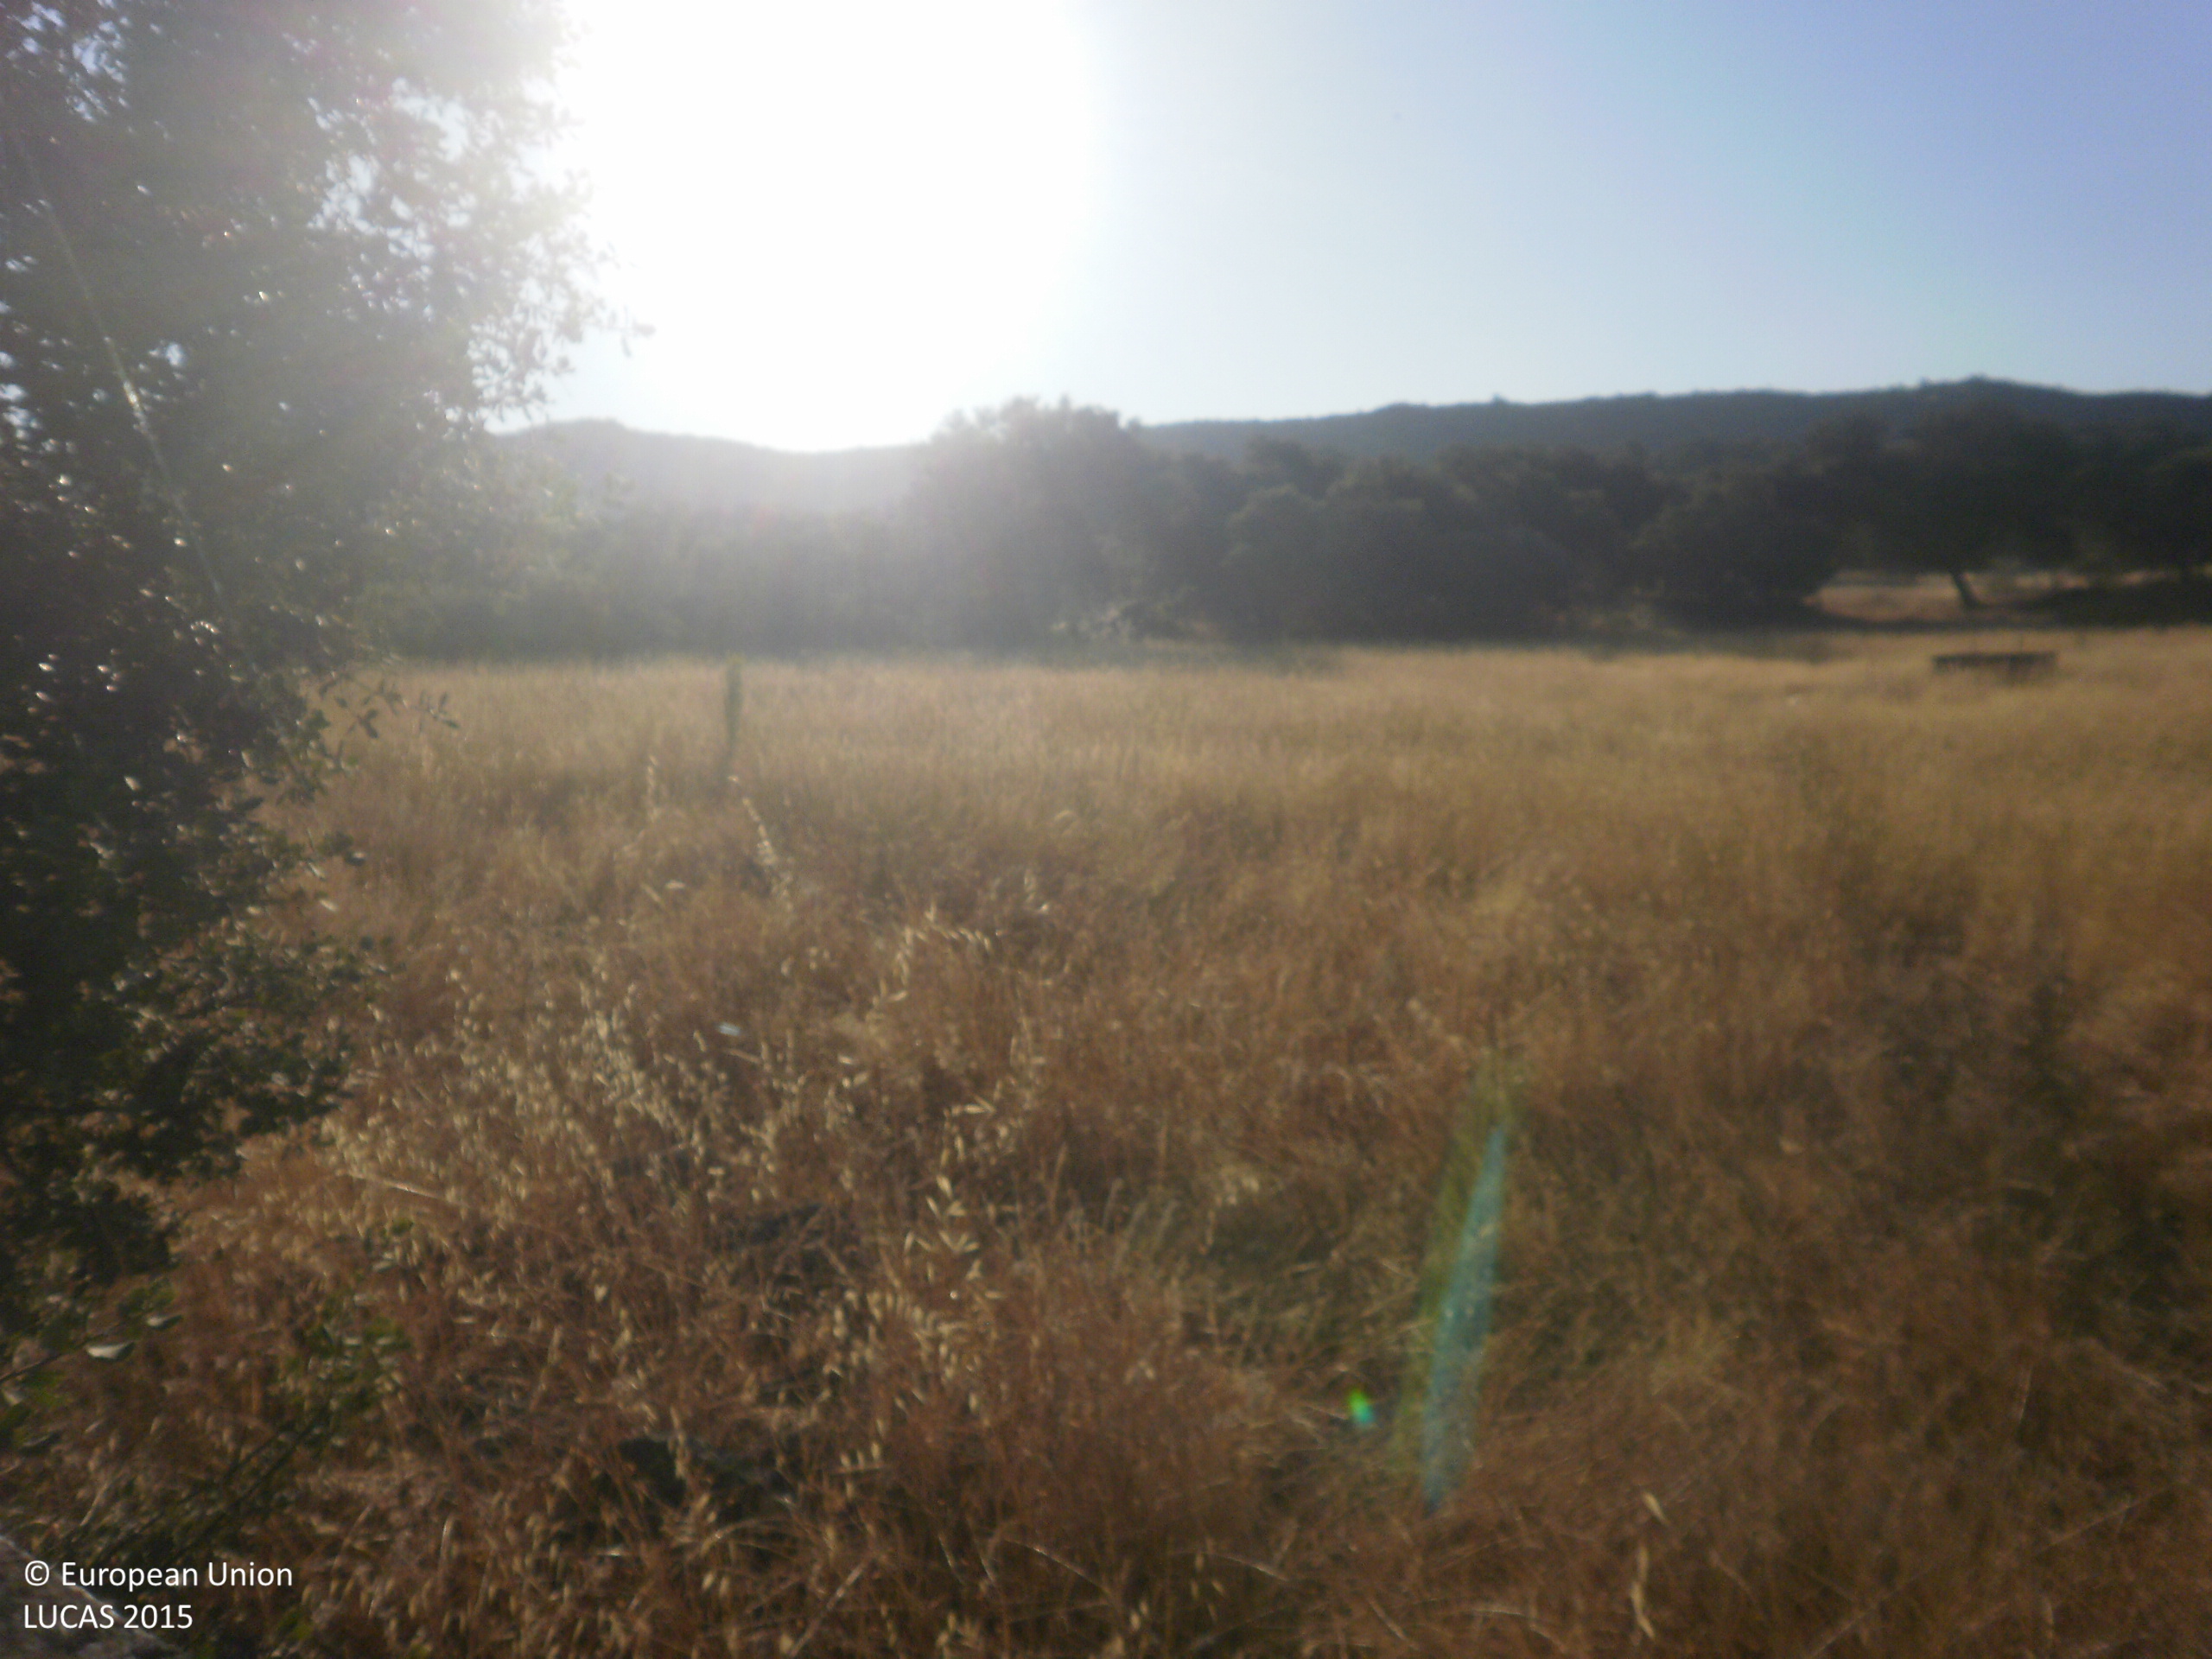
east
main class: Woodland
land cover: Broadleaved woodland
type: broadleaved evergreen forest
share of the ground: 50 - 75 %
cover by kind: broadleaved forest trees 100 %
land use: Agriculture (excluding fallow land and kitchen gardens)
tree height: > 5 m
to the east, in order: Broadleaved woodland; Dry stone walls; Tracks; Dry stone walls; Broadleaved woodland
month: June
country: ES
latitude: 39.2728
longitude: -6.0189
